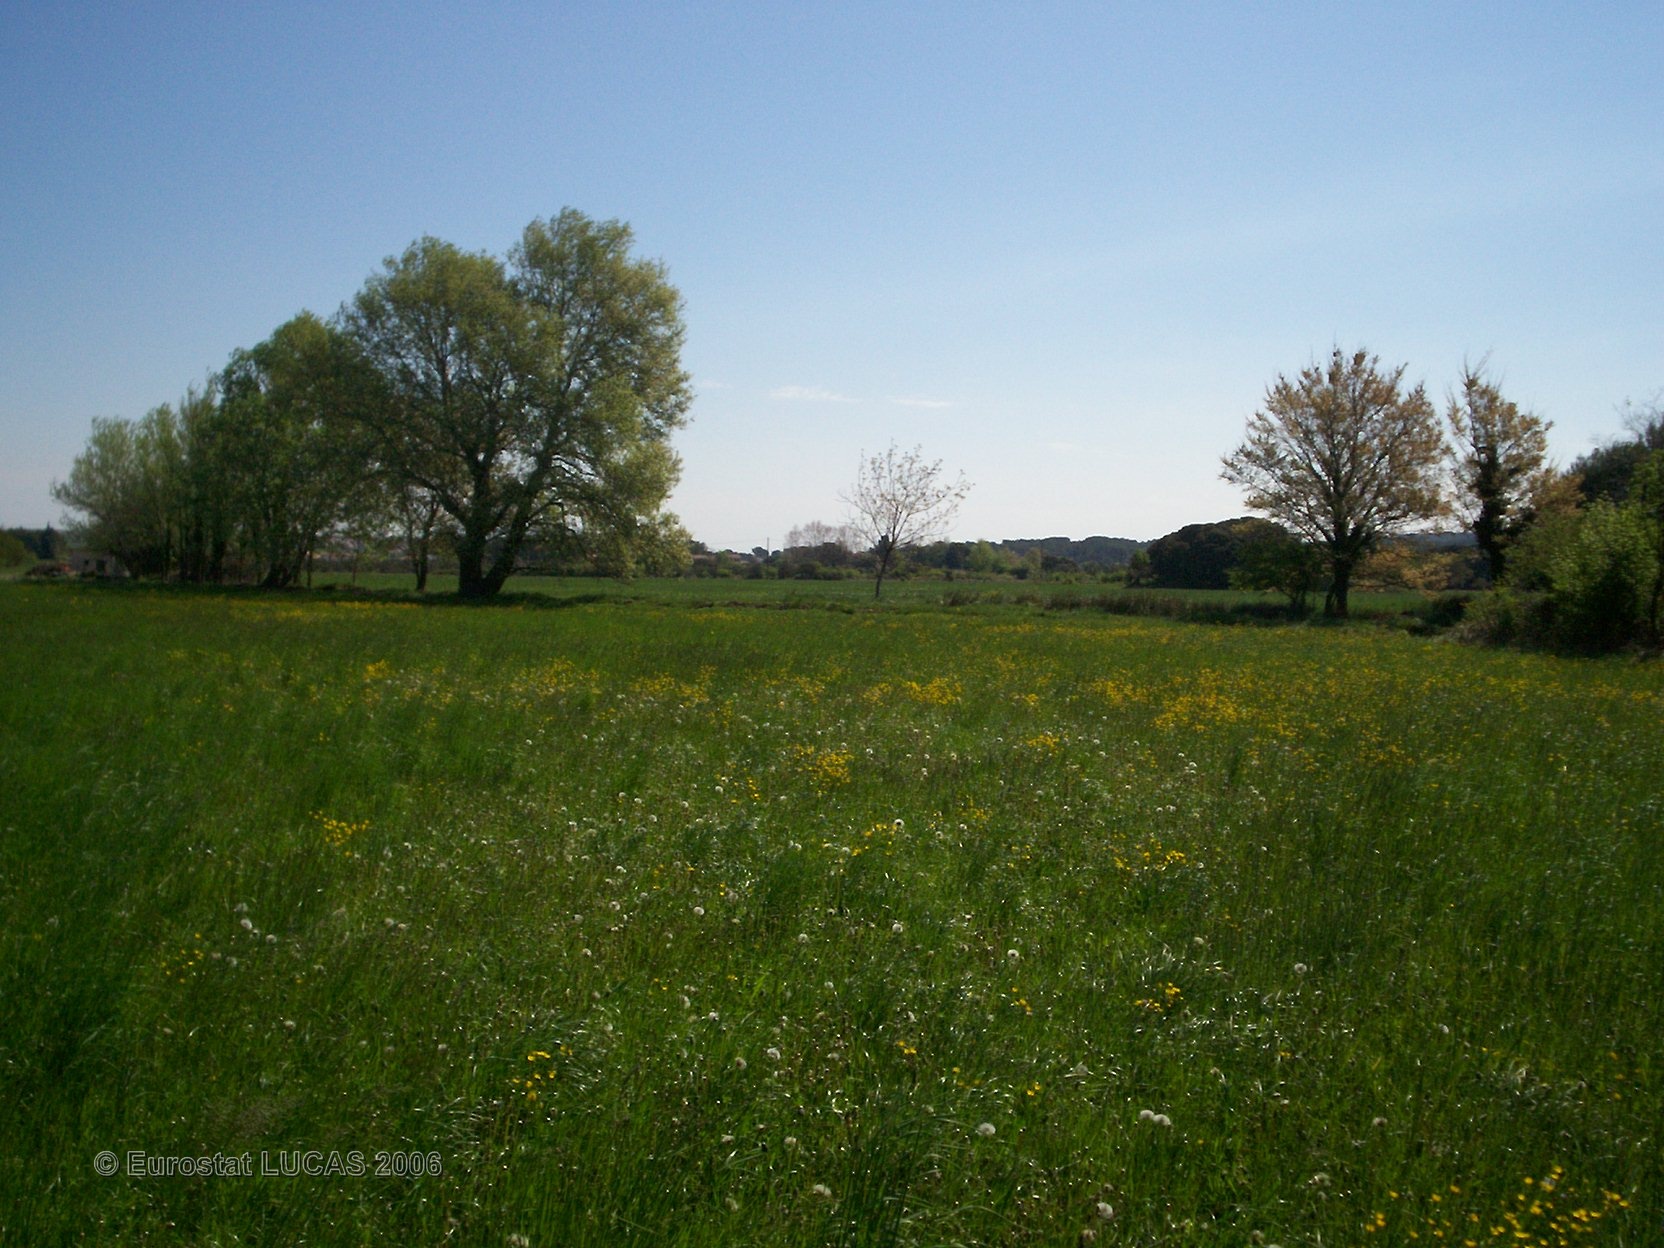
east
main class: Grassland
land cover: Grassland without tree/shrub cover
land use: Agriculture (excluding fallow land and kitchen gardens)
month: April
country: FR
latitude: 43.5839
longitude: 5.0930
